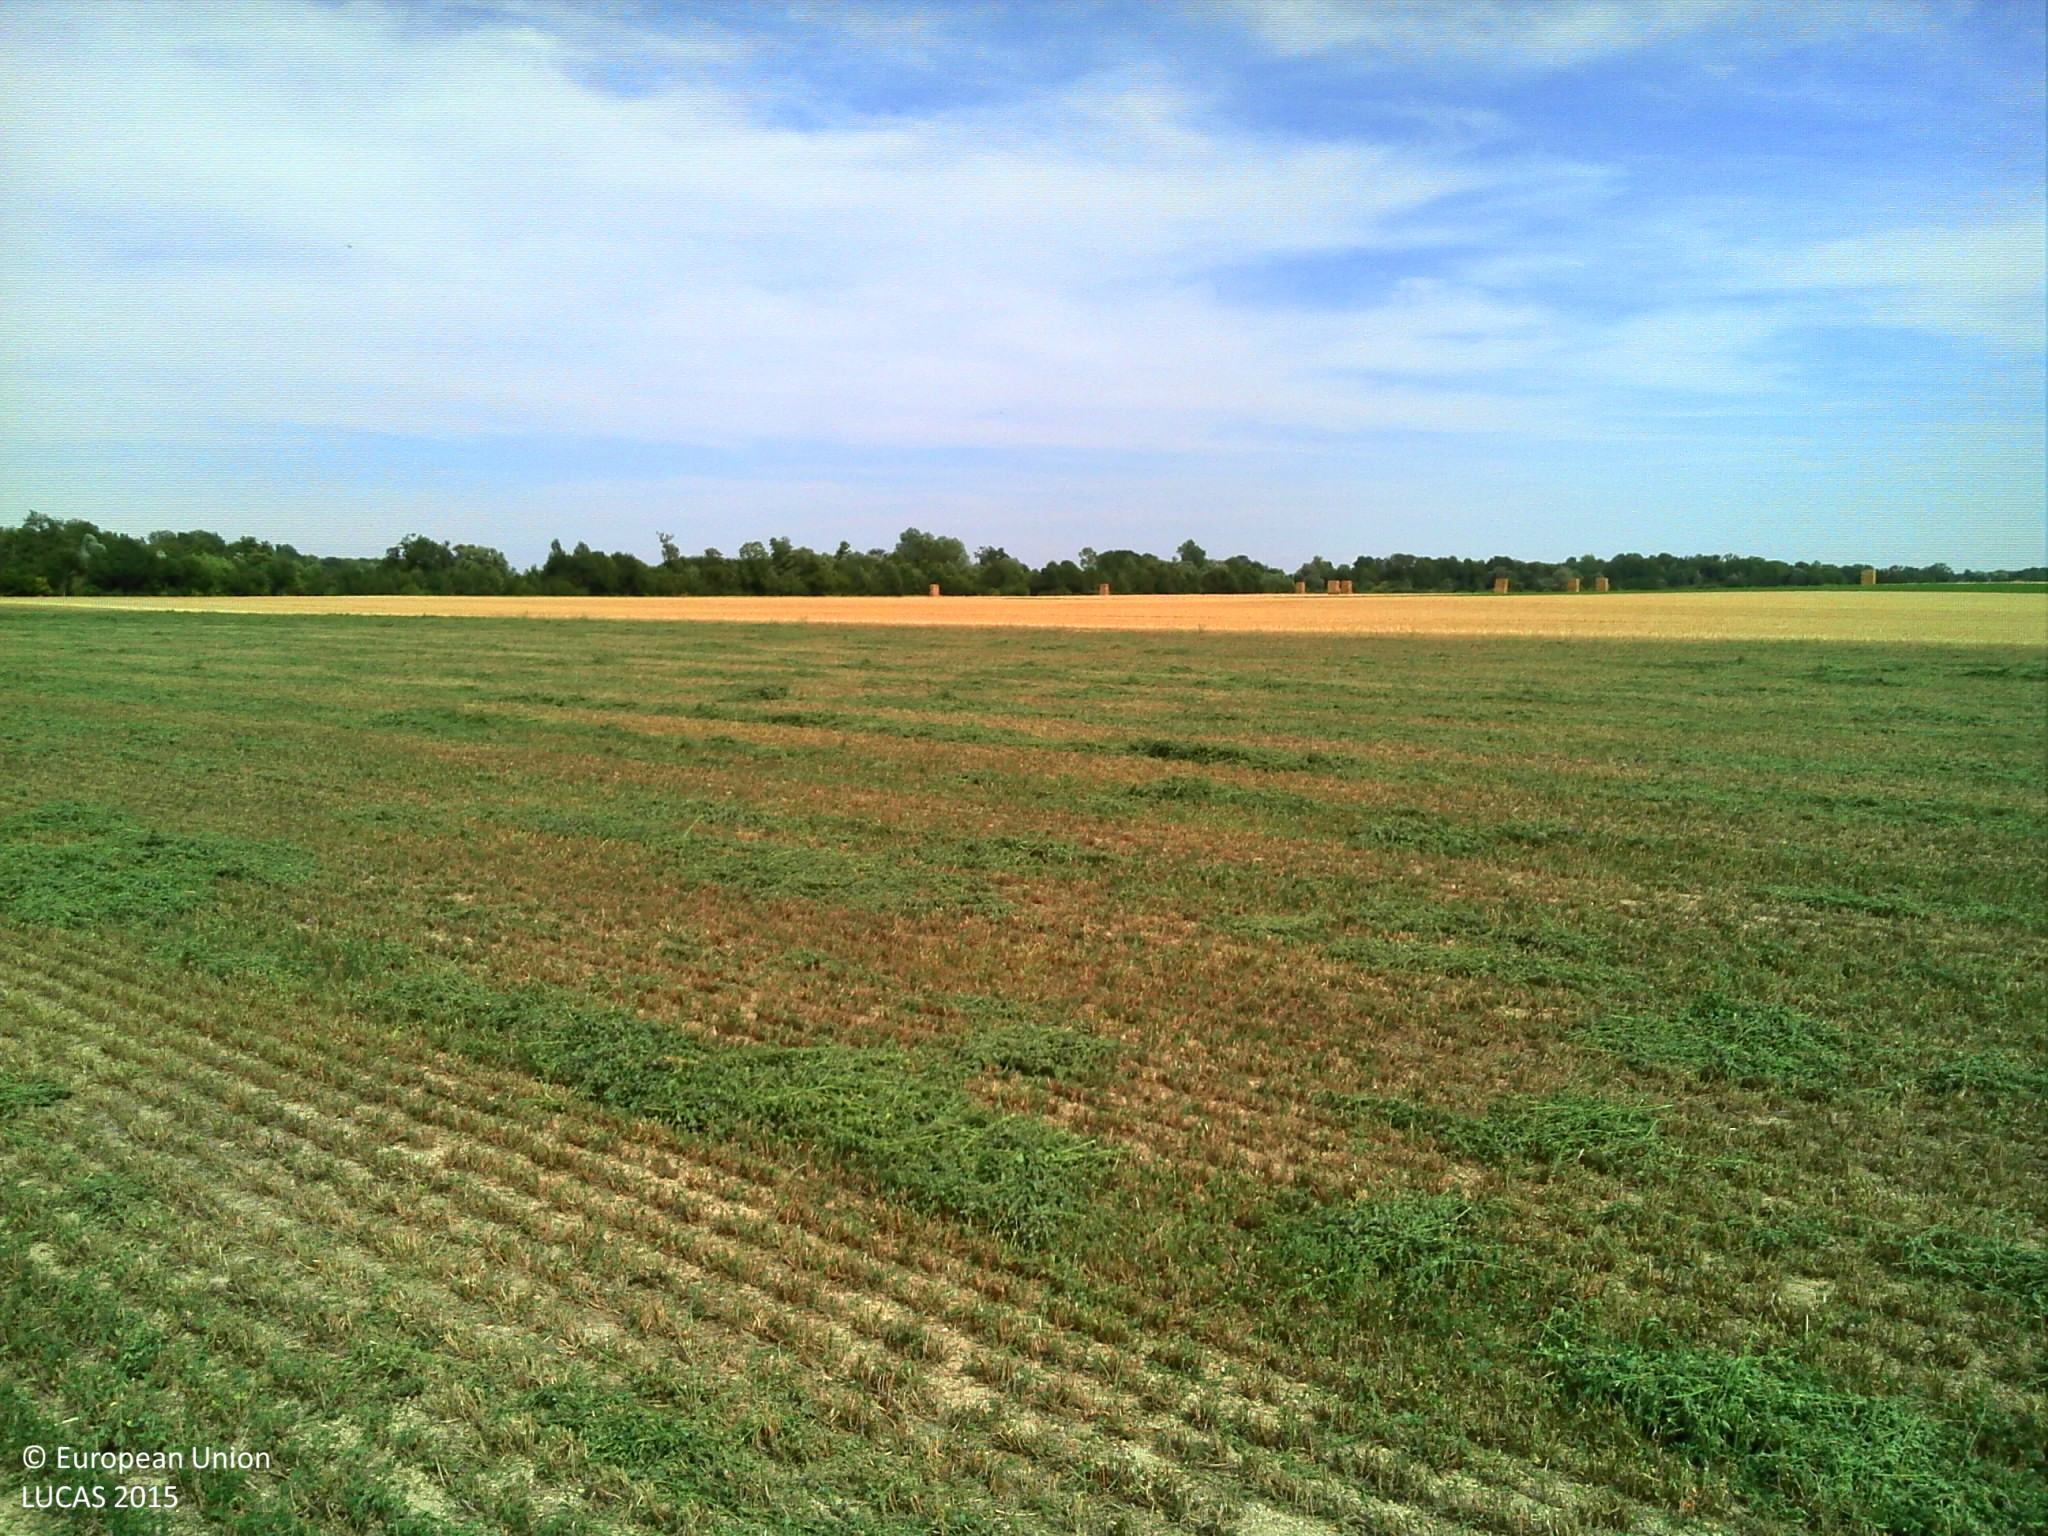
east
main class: Cropland
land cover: Clovers
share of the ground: > 75 %
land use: Agriculture (excluding fallow land and kitchen gardens)
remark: Harvested field
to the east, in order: Clovers; Grass margins; Tracks; Grass margins; Common wheat; Clovers
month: August
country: FR
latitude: 49.1213
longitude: 4.2821
